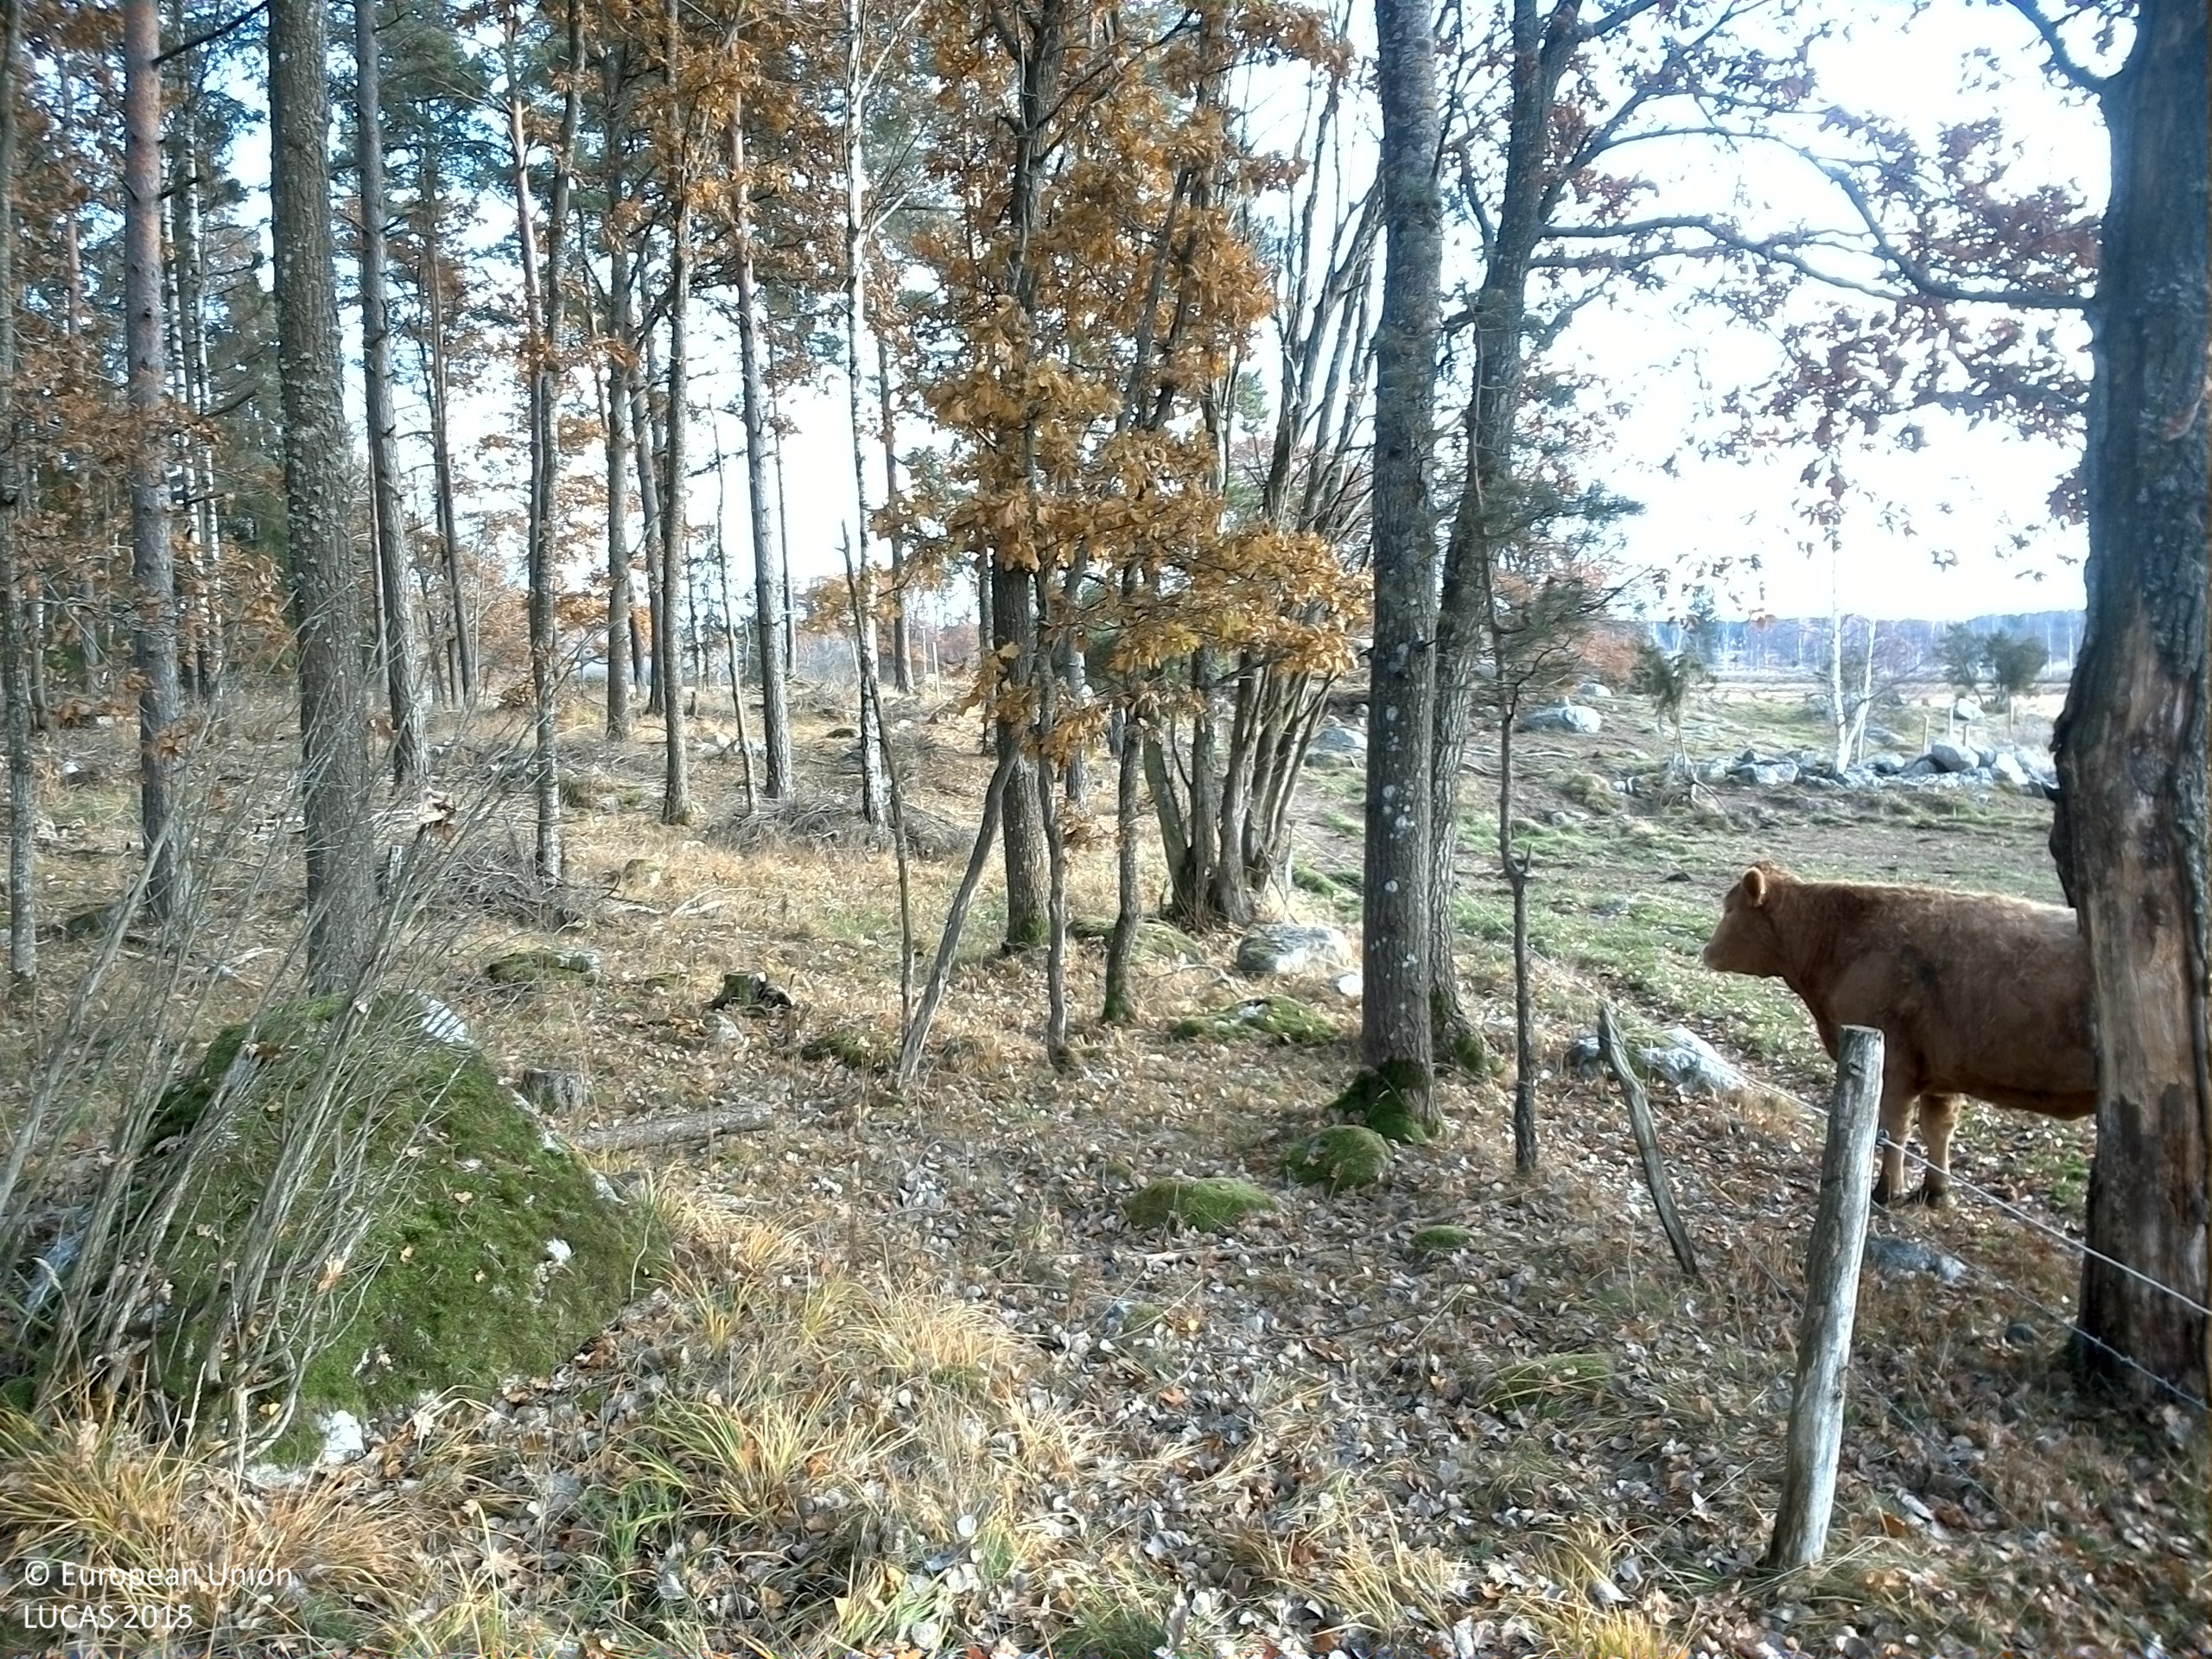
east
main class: Woodland
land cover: Pine dominated mixed woodland
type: boreal forest
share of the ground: 50 - 75 %
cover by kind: coniferous forest trees 25 %, broadleaved forest trees 25 %, herbaceous plants 25 %, shrubs 15 %, consolidated bare surface 10 %
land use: Forestry
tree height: > 5 m
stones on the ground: < 10 %
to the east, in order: Pine dominated mixed woodland; Electric lines; Grassland with sparse tree/shrub cover; Electric lines; Grass margins; Other bare soil; Fences; Grassland with sparse tree/shrub cover; Fences; Grassland without tree/shrub cover
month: October
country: SE
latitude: 59.3105
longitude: 16.8272
